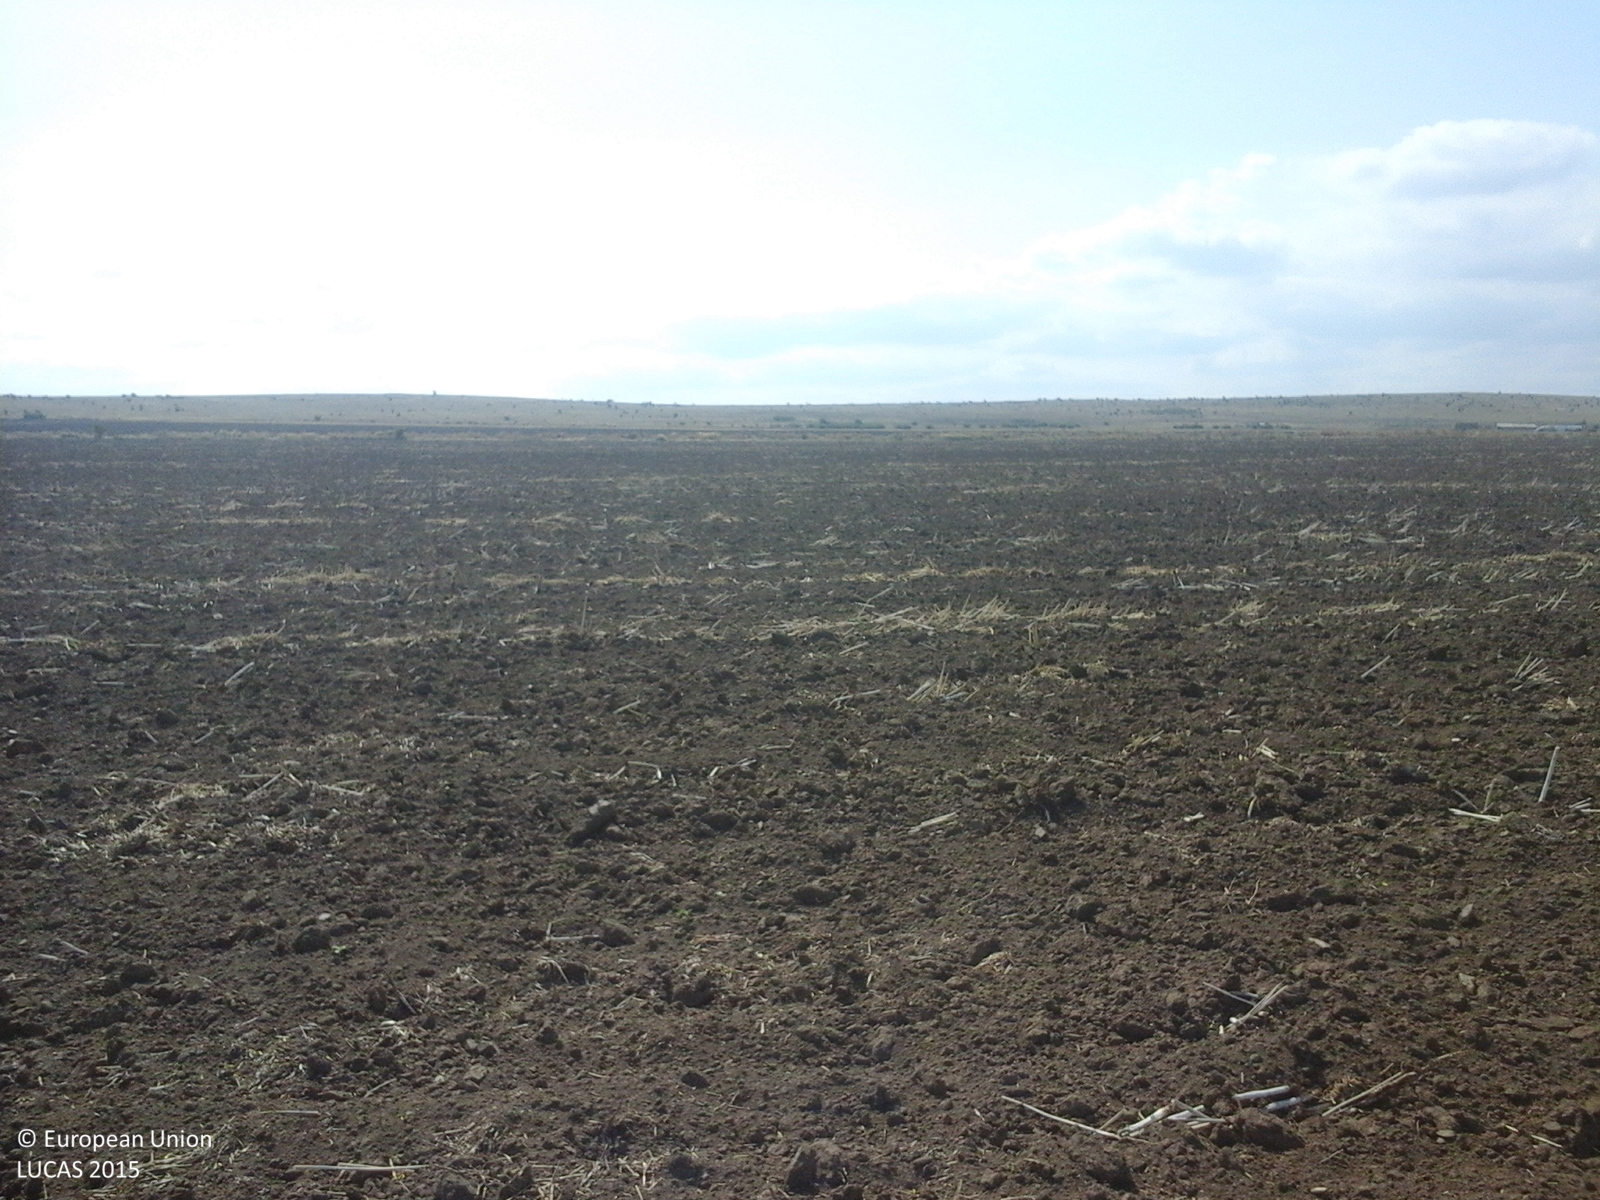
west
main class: Cropland
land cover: Rape and turnip rape
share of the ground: < 10 %
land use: Agriculture (excluding fallow land and kitchen gardens)
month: August
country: RO
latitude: 44.8182
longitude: 28.8680
